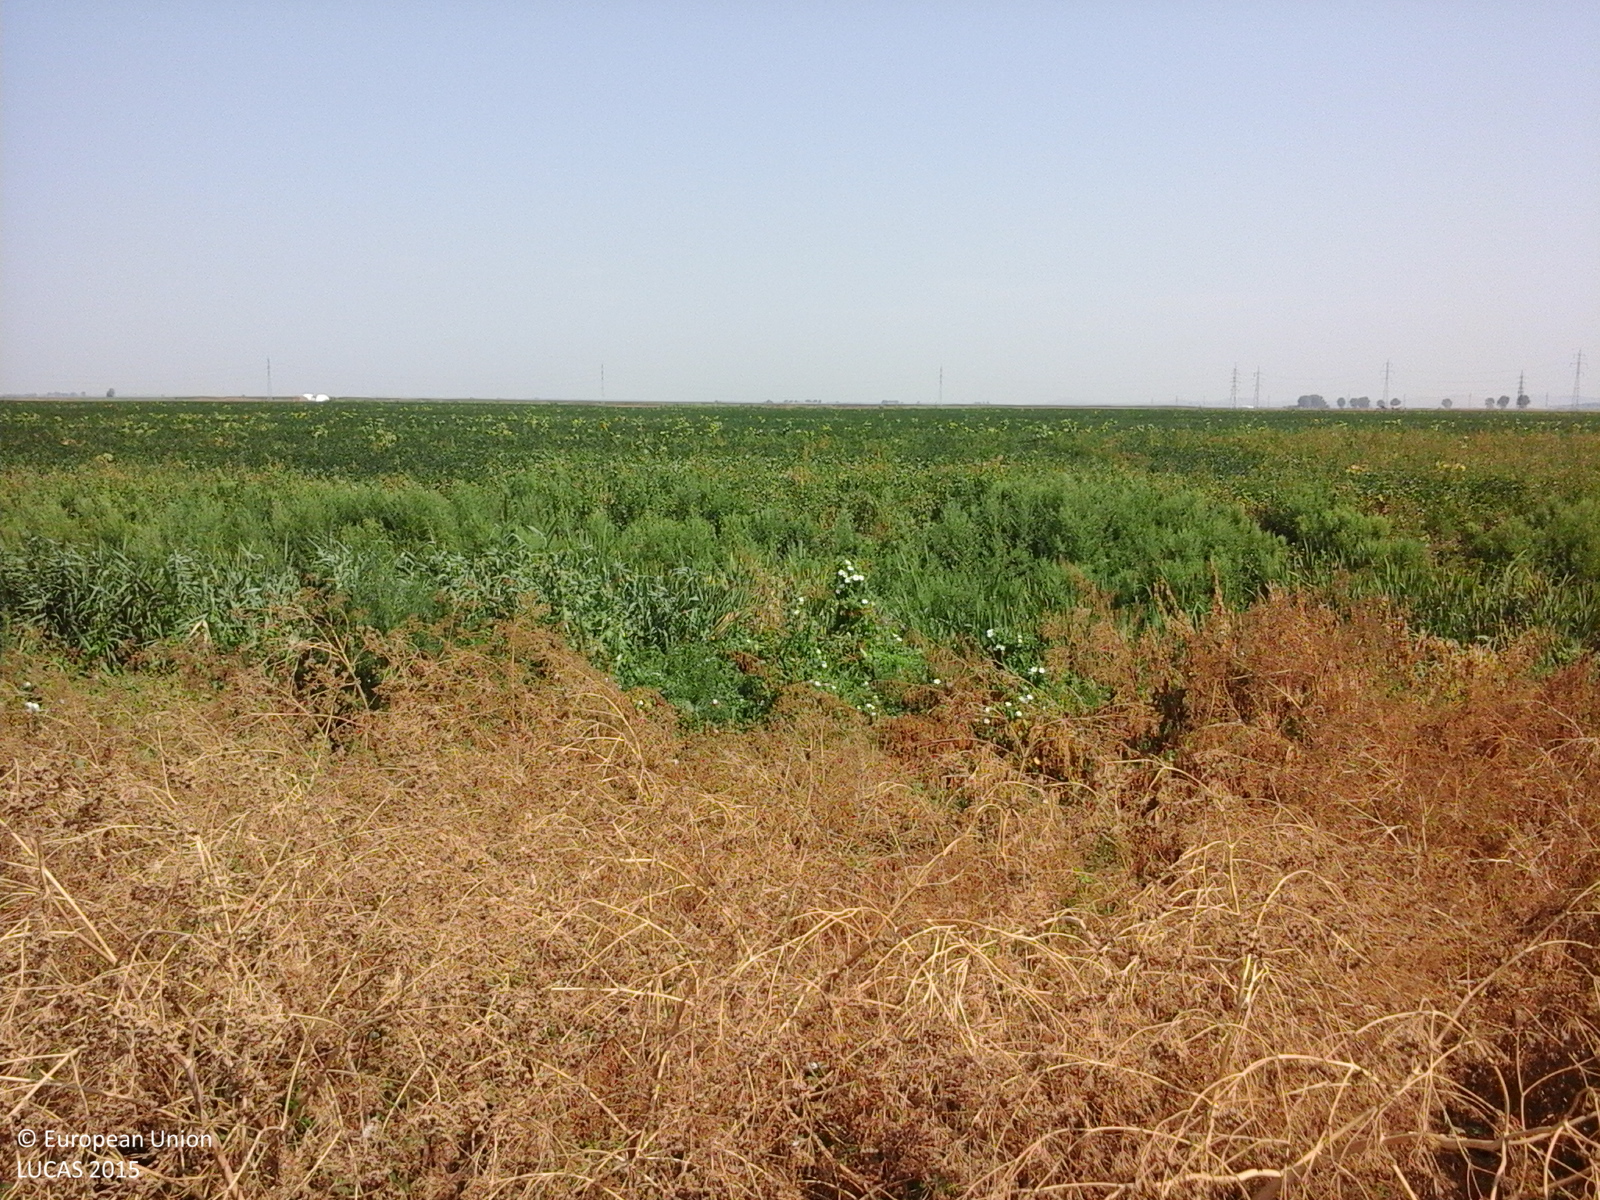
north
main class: Cropland
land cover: Soya
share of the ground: > 75 %
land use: Agriculture (excluding fallow land and kitchen gardens)
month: August
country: RO
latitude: 45.1342
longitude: 28.0314
